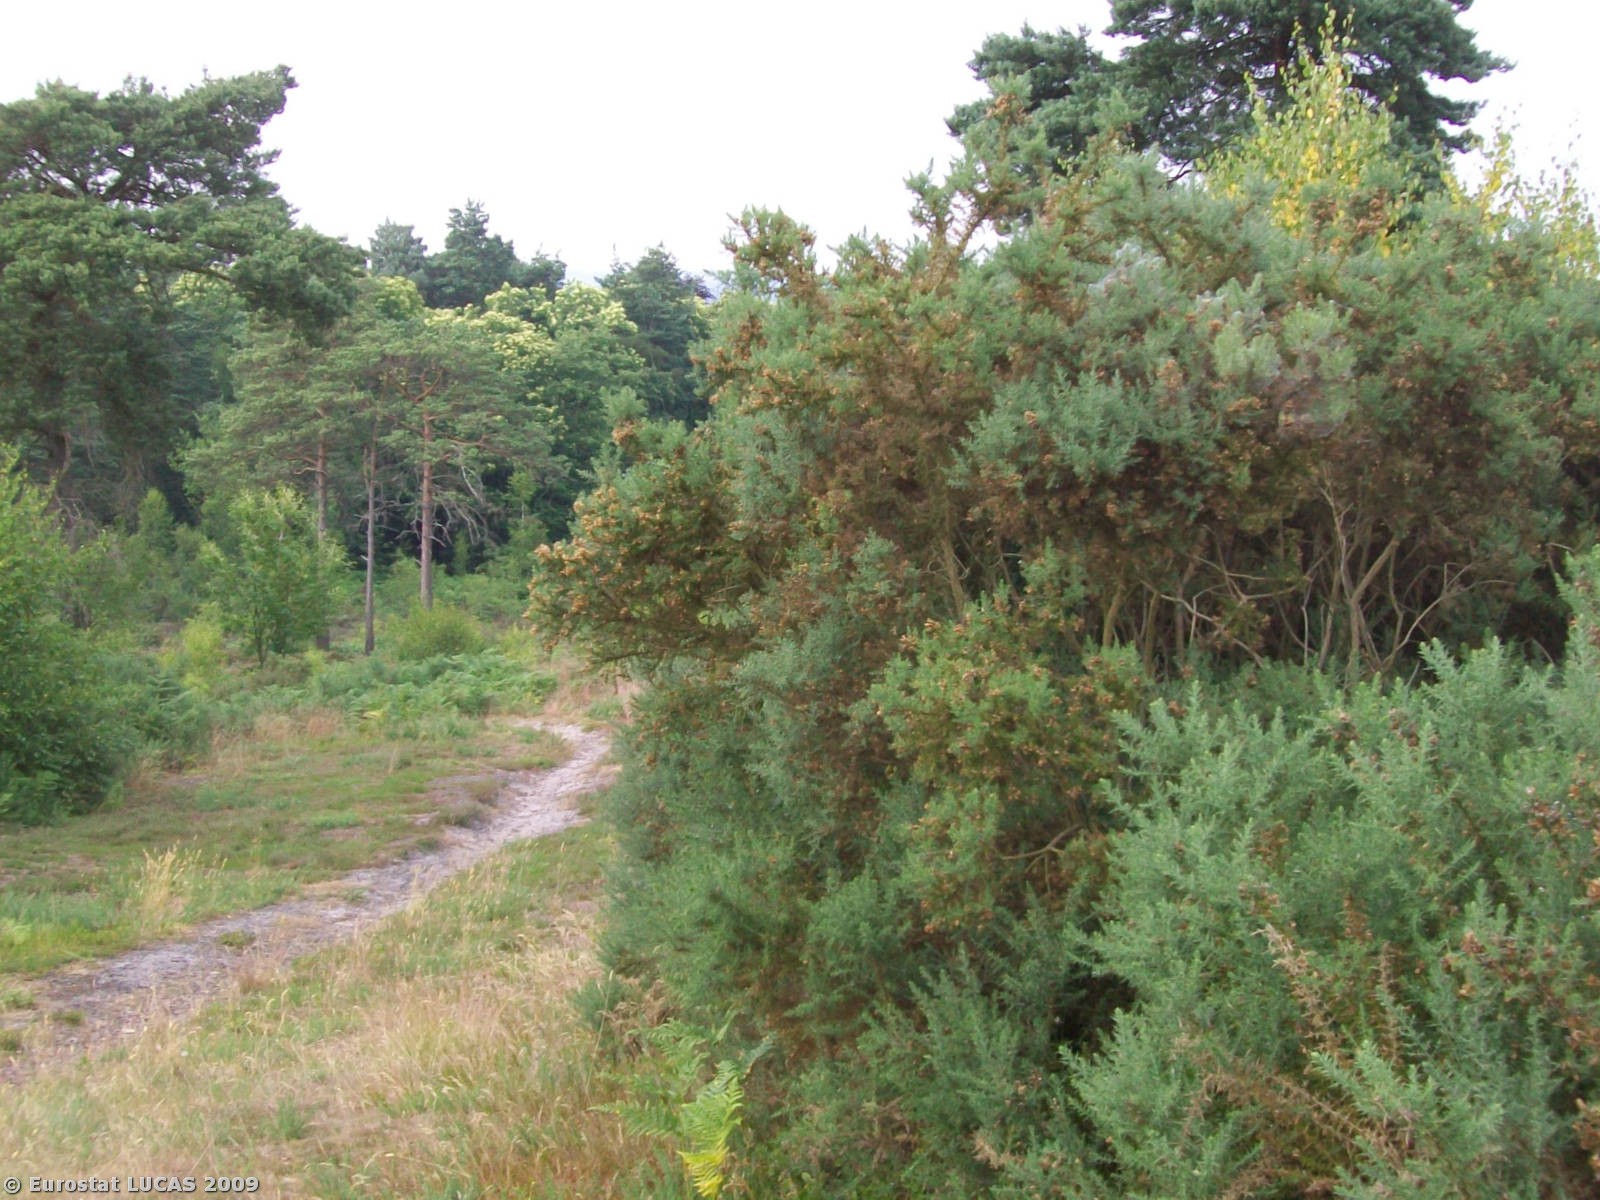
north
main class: Shrubland
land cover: Shrubland with sparse tree cover
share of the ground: > 75 %
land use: Amenities, museums, leisure
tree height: > 5 m
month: July
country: GB
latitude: 51.1521
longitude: -0.6627
